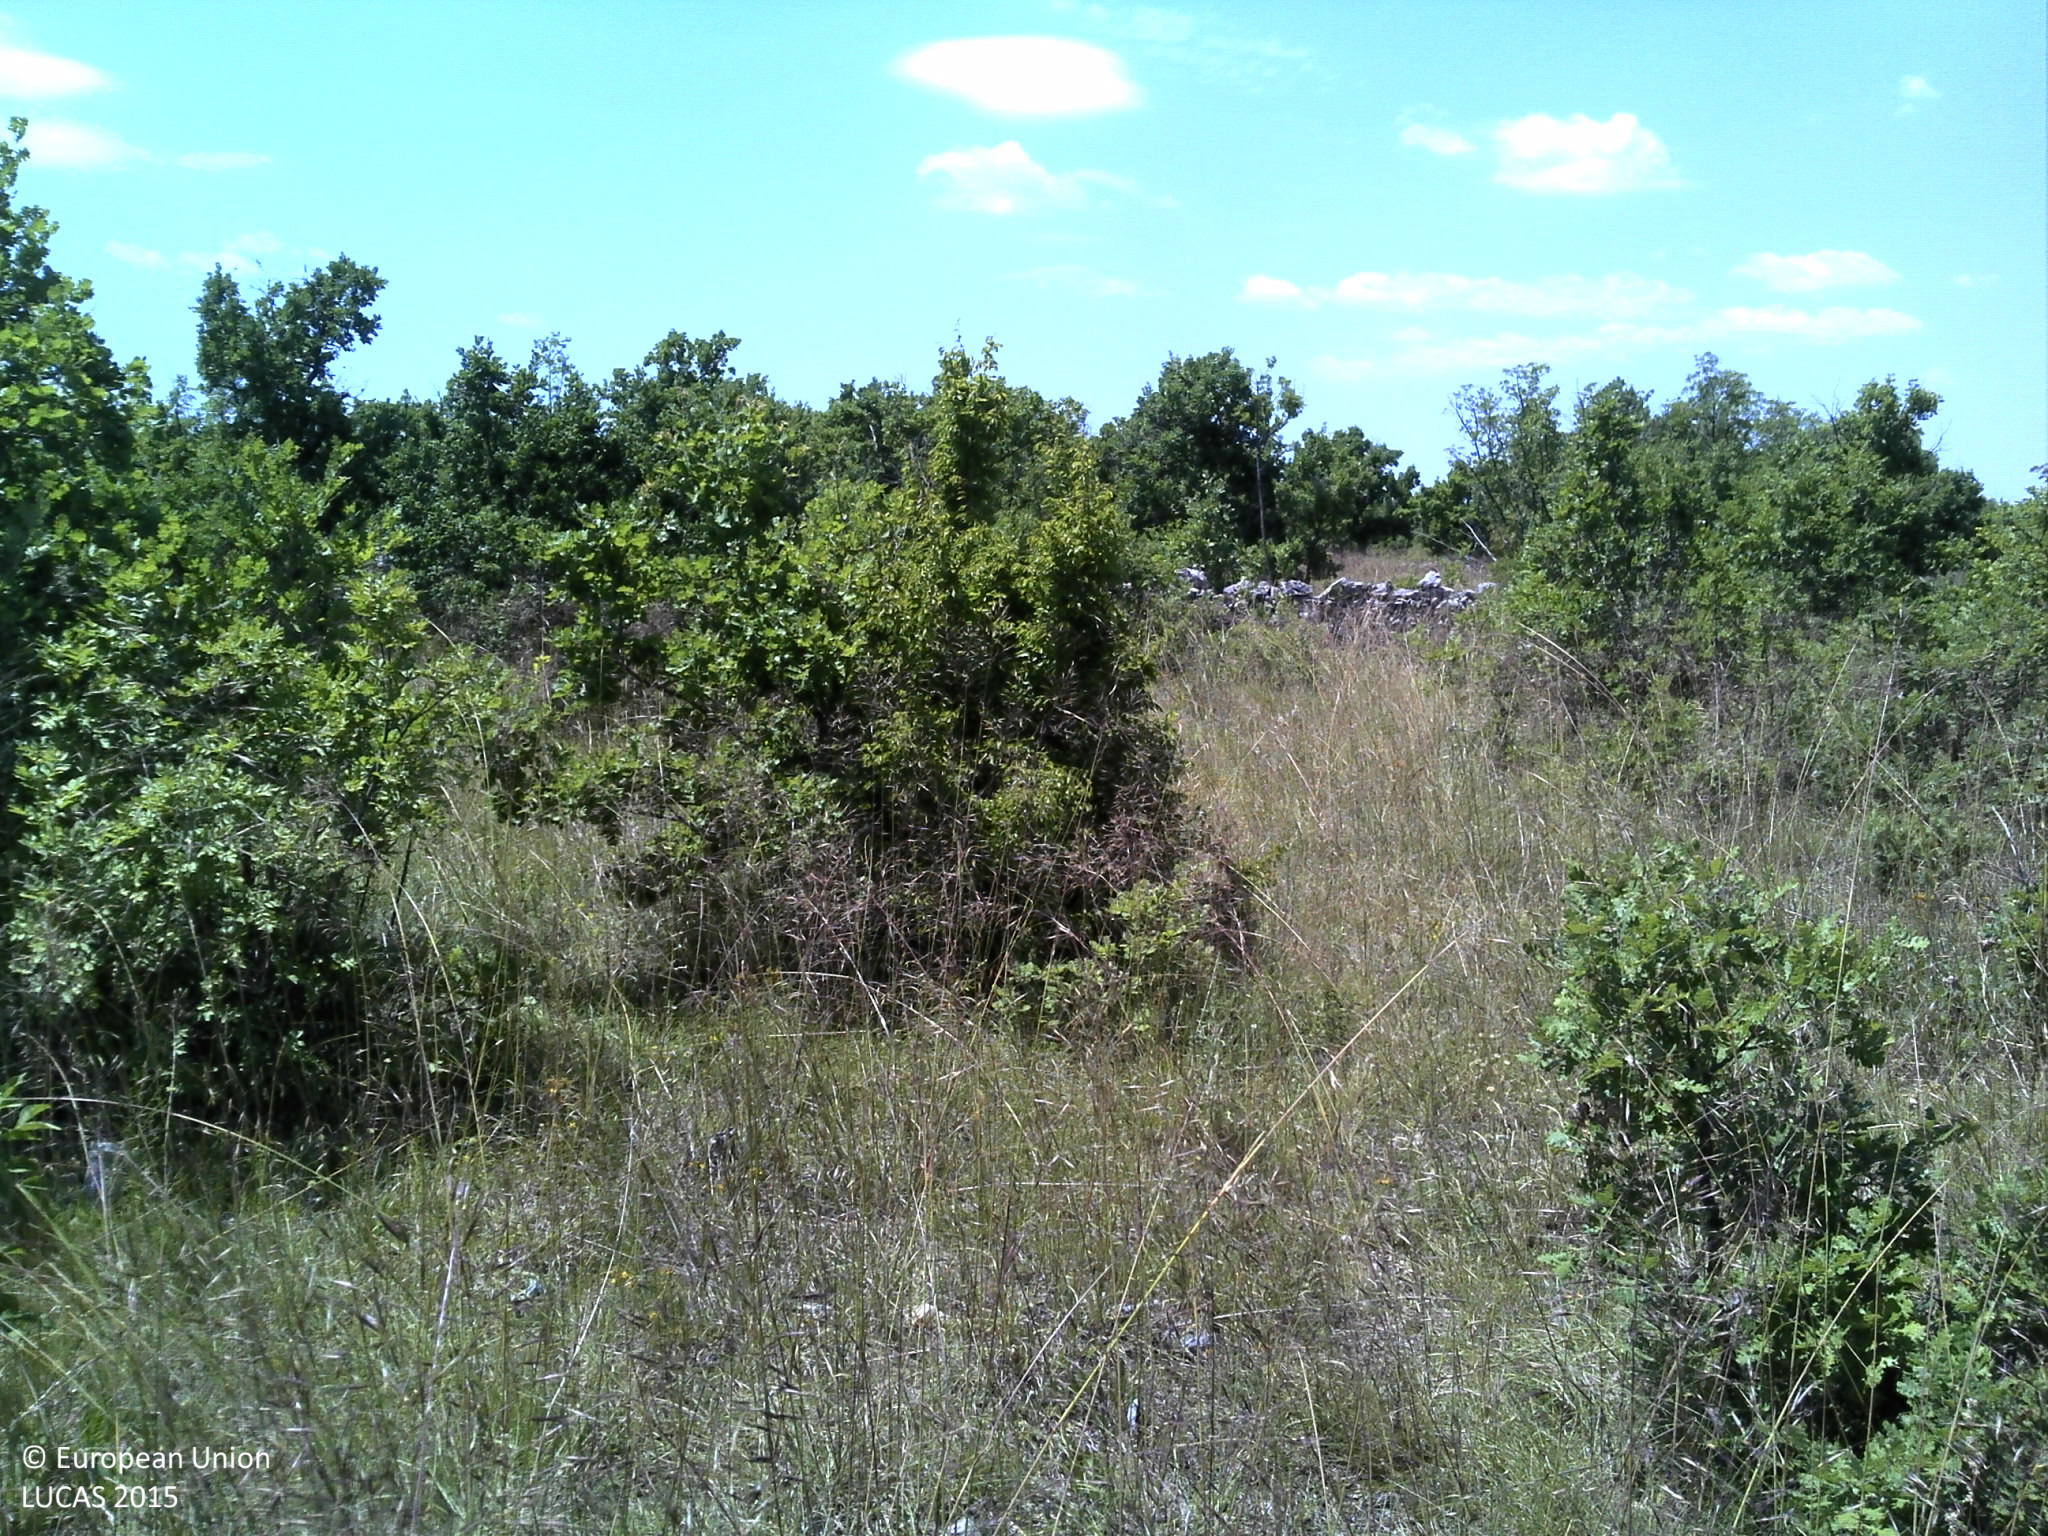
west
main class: Shrubland
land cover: Shrubland with sparse tree cover
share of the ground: 25 - 50 %
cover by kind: shrubs 45 %, herbaceous plants 40 %, broadleaved forest trees 5 %, consolidated bare surface 5 %, unconsolidated bare surface 5 %
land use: Semi-natural and natural areas not in use
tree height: < 5 m
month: July
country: HR
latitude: 43.9053
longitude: 16.0057
